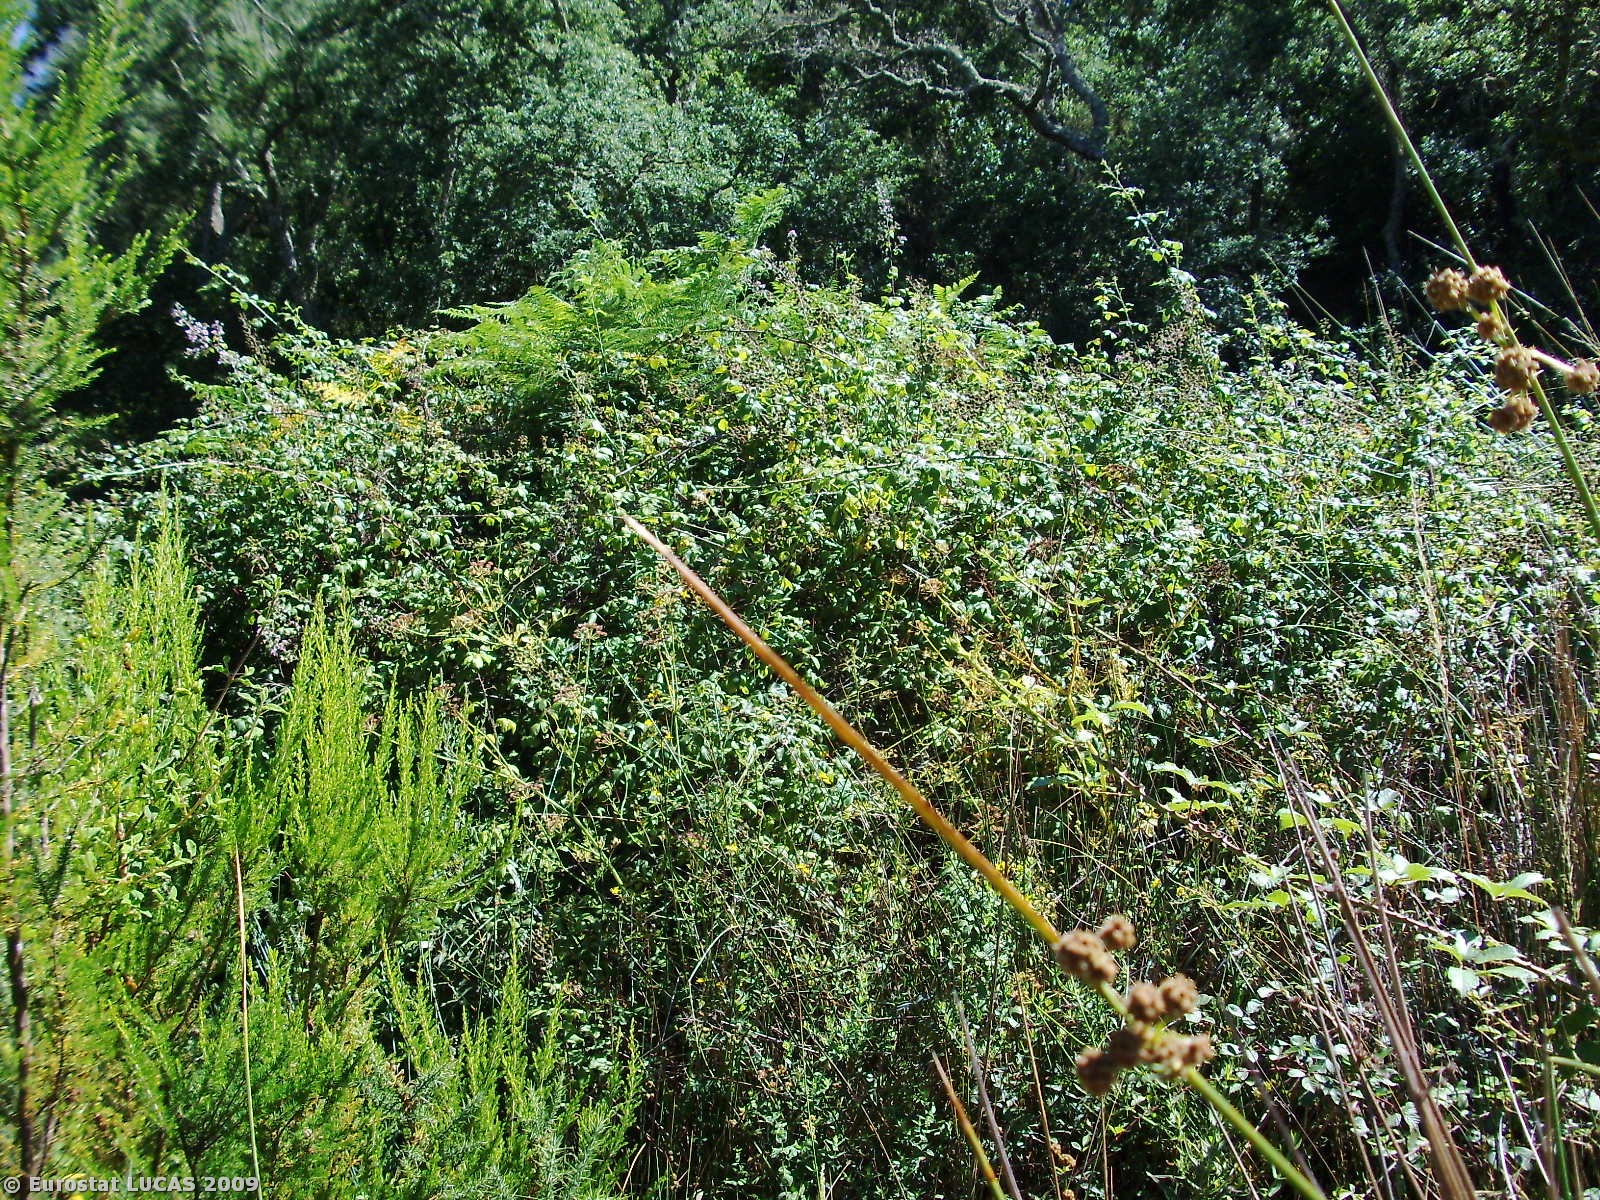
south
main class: Shrubland
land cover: Shrubland with sparse tree cover
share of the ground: > 75 %
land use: Unused
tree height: > 5 m
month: July
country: PT
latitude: 37.6439
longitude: -8.4742
